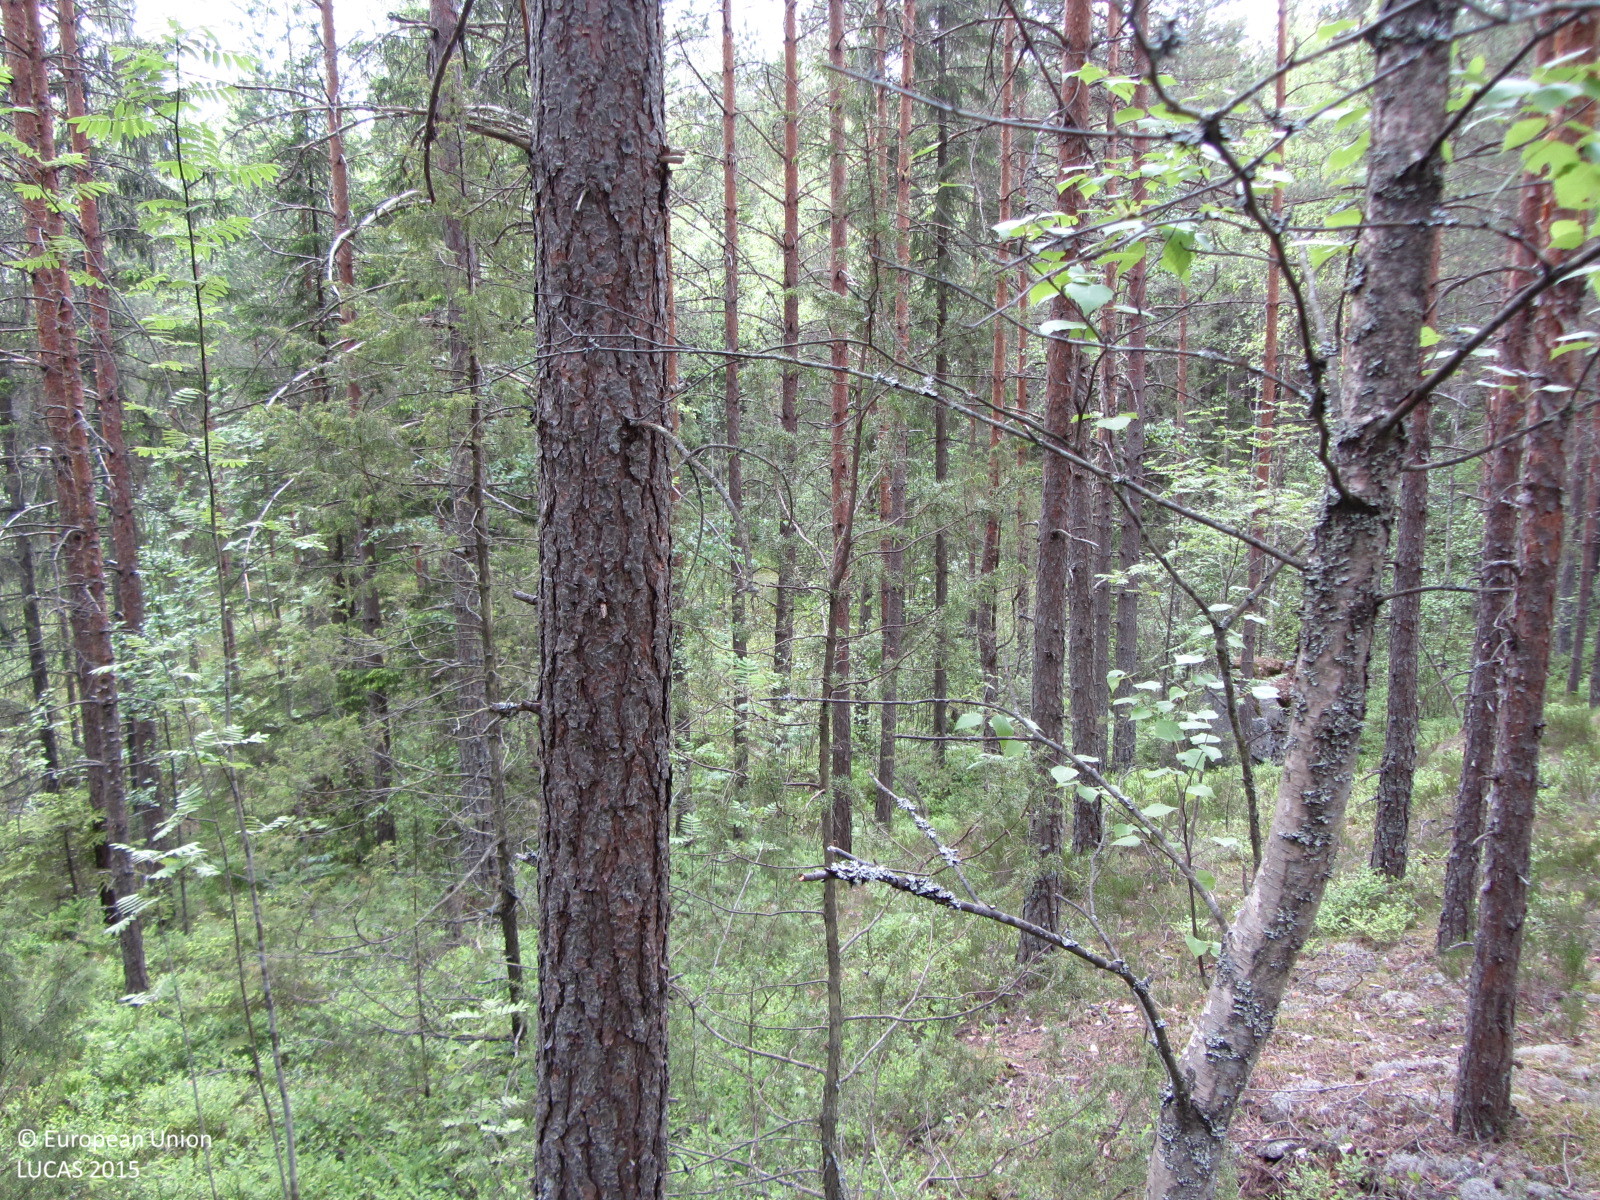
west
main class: Woodland
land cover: Pine dominated mixed woodland
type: boreal forest
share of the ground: > 75 %
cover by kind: coniferous forest trees 55 %, broadleaved forest trees 20 %, herbaceous plants 10 %, lichens and mosses 10 %, shrubs 5 %
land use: Semi-natural and natural areas not in use
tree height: > 5 m
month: June
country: FI
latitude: 60.2960
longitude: 24.6017
